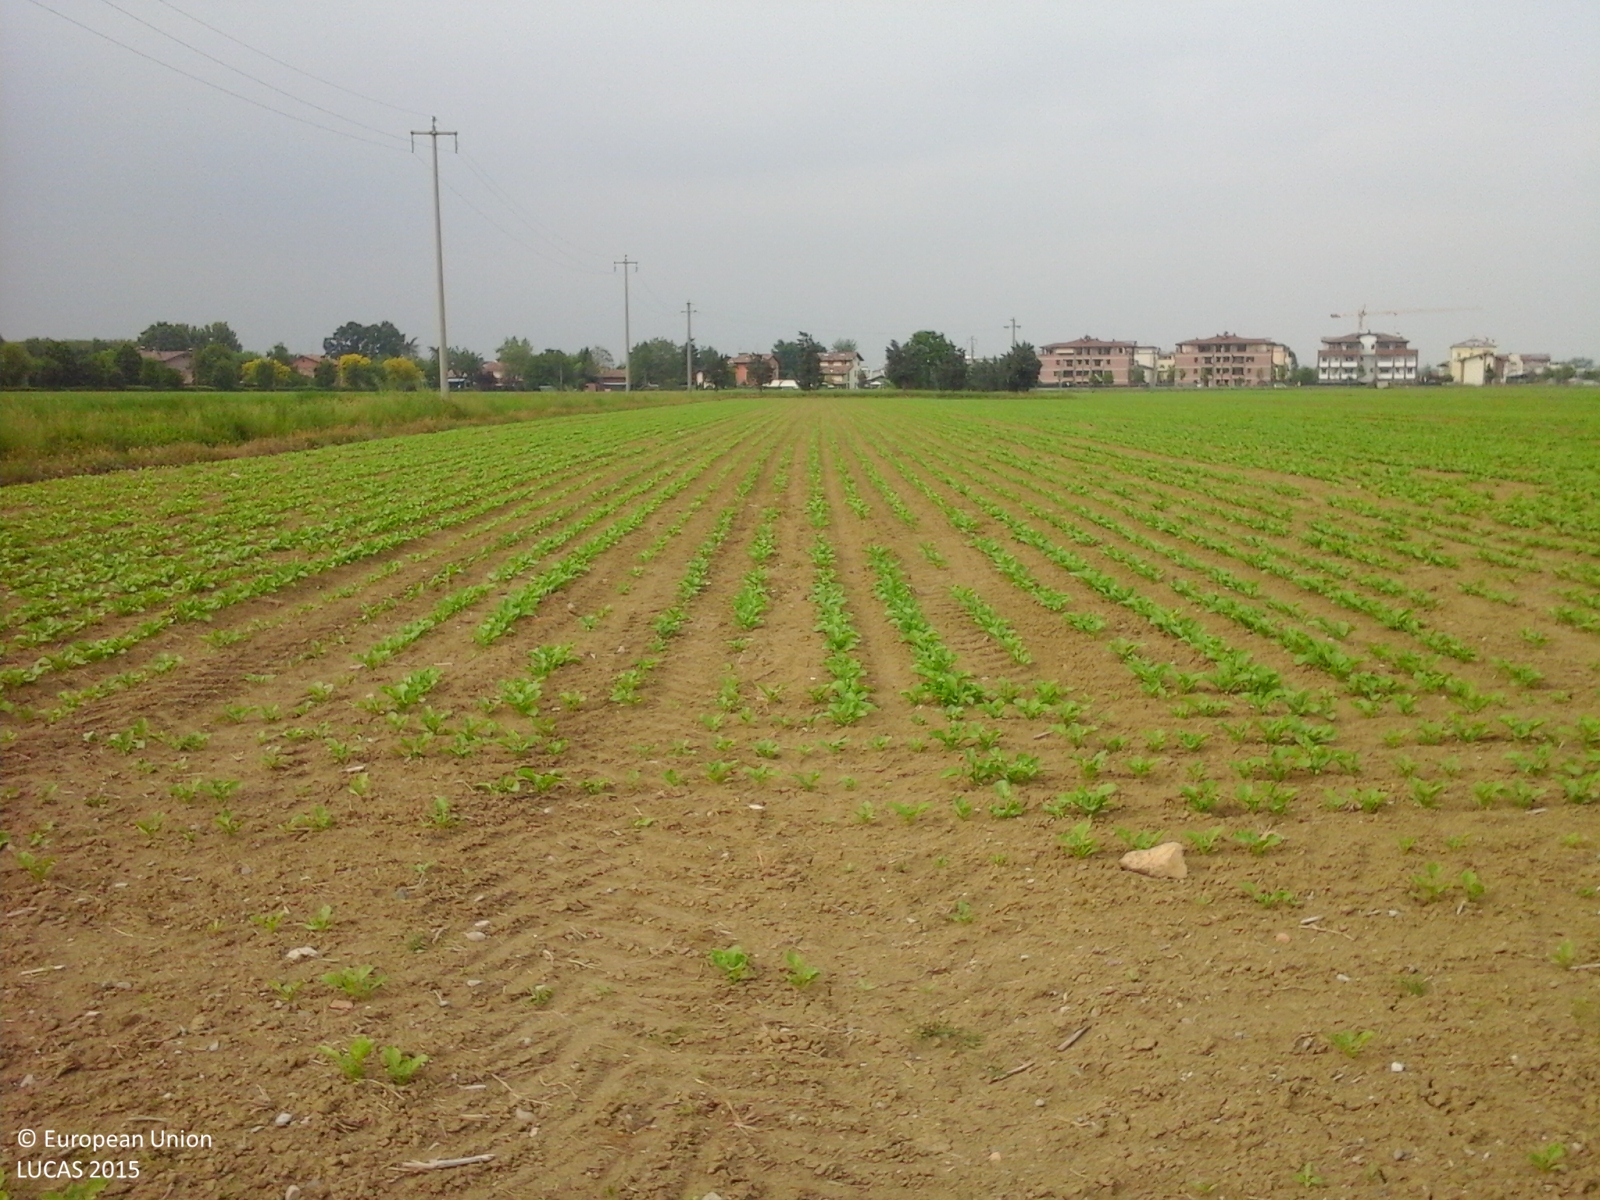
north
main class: Cropland
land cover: Sugar beet
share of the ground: 10 - 25 %
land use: Agriculture (excluding fallow land and kitchen gardens)
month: May
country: IT
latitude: 44.5629
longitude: 10.9171
